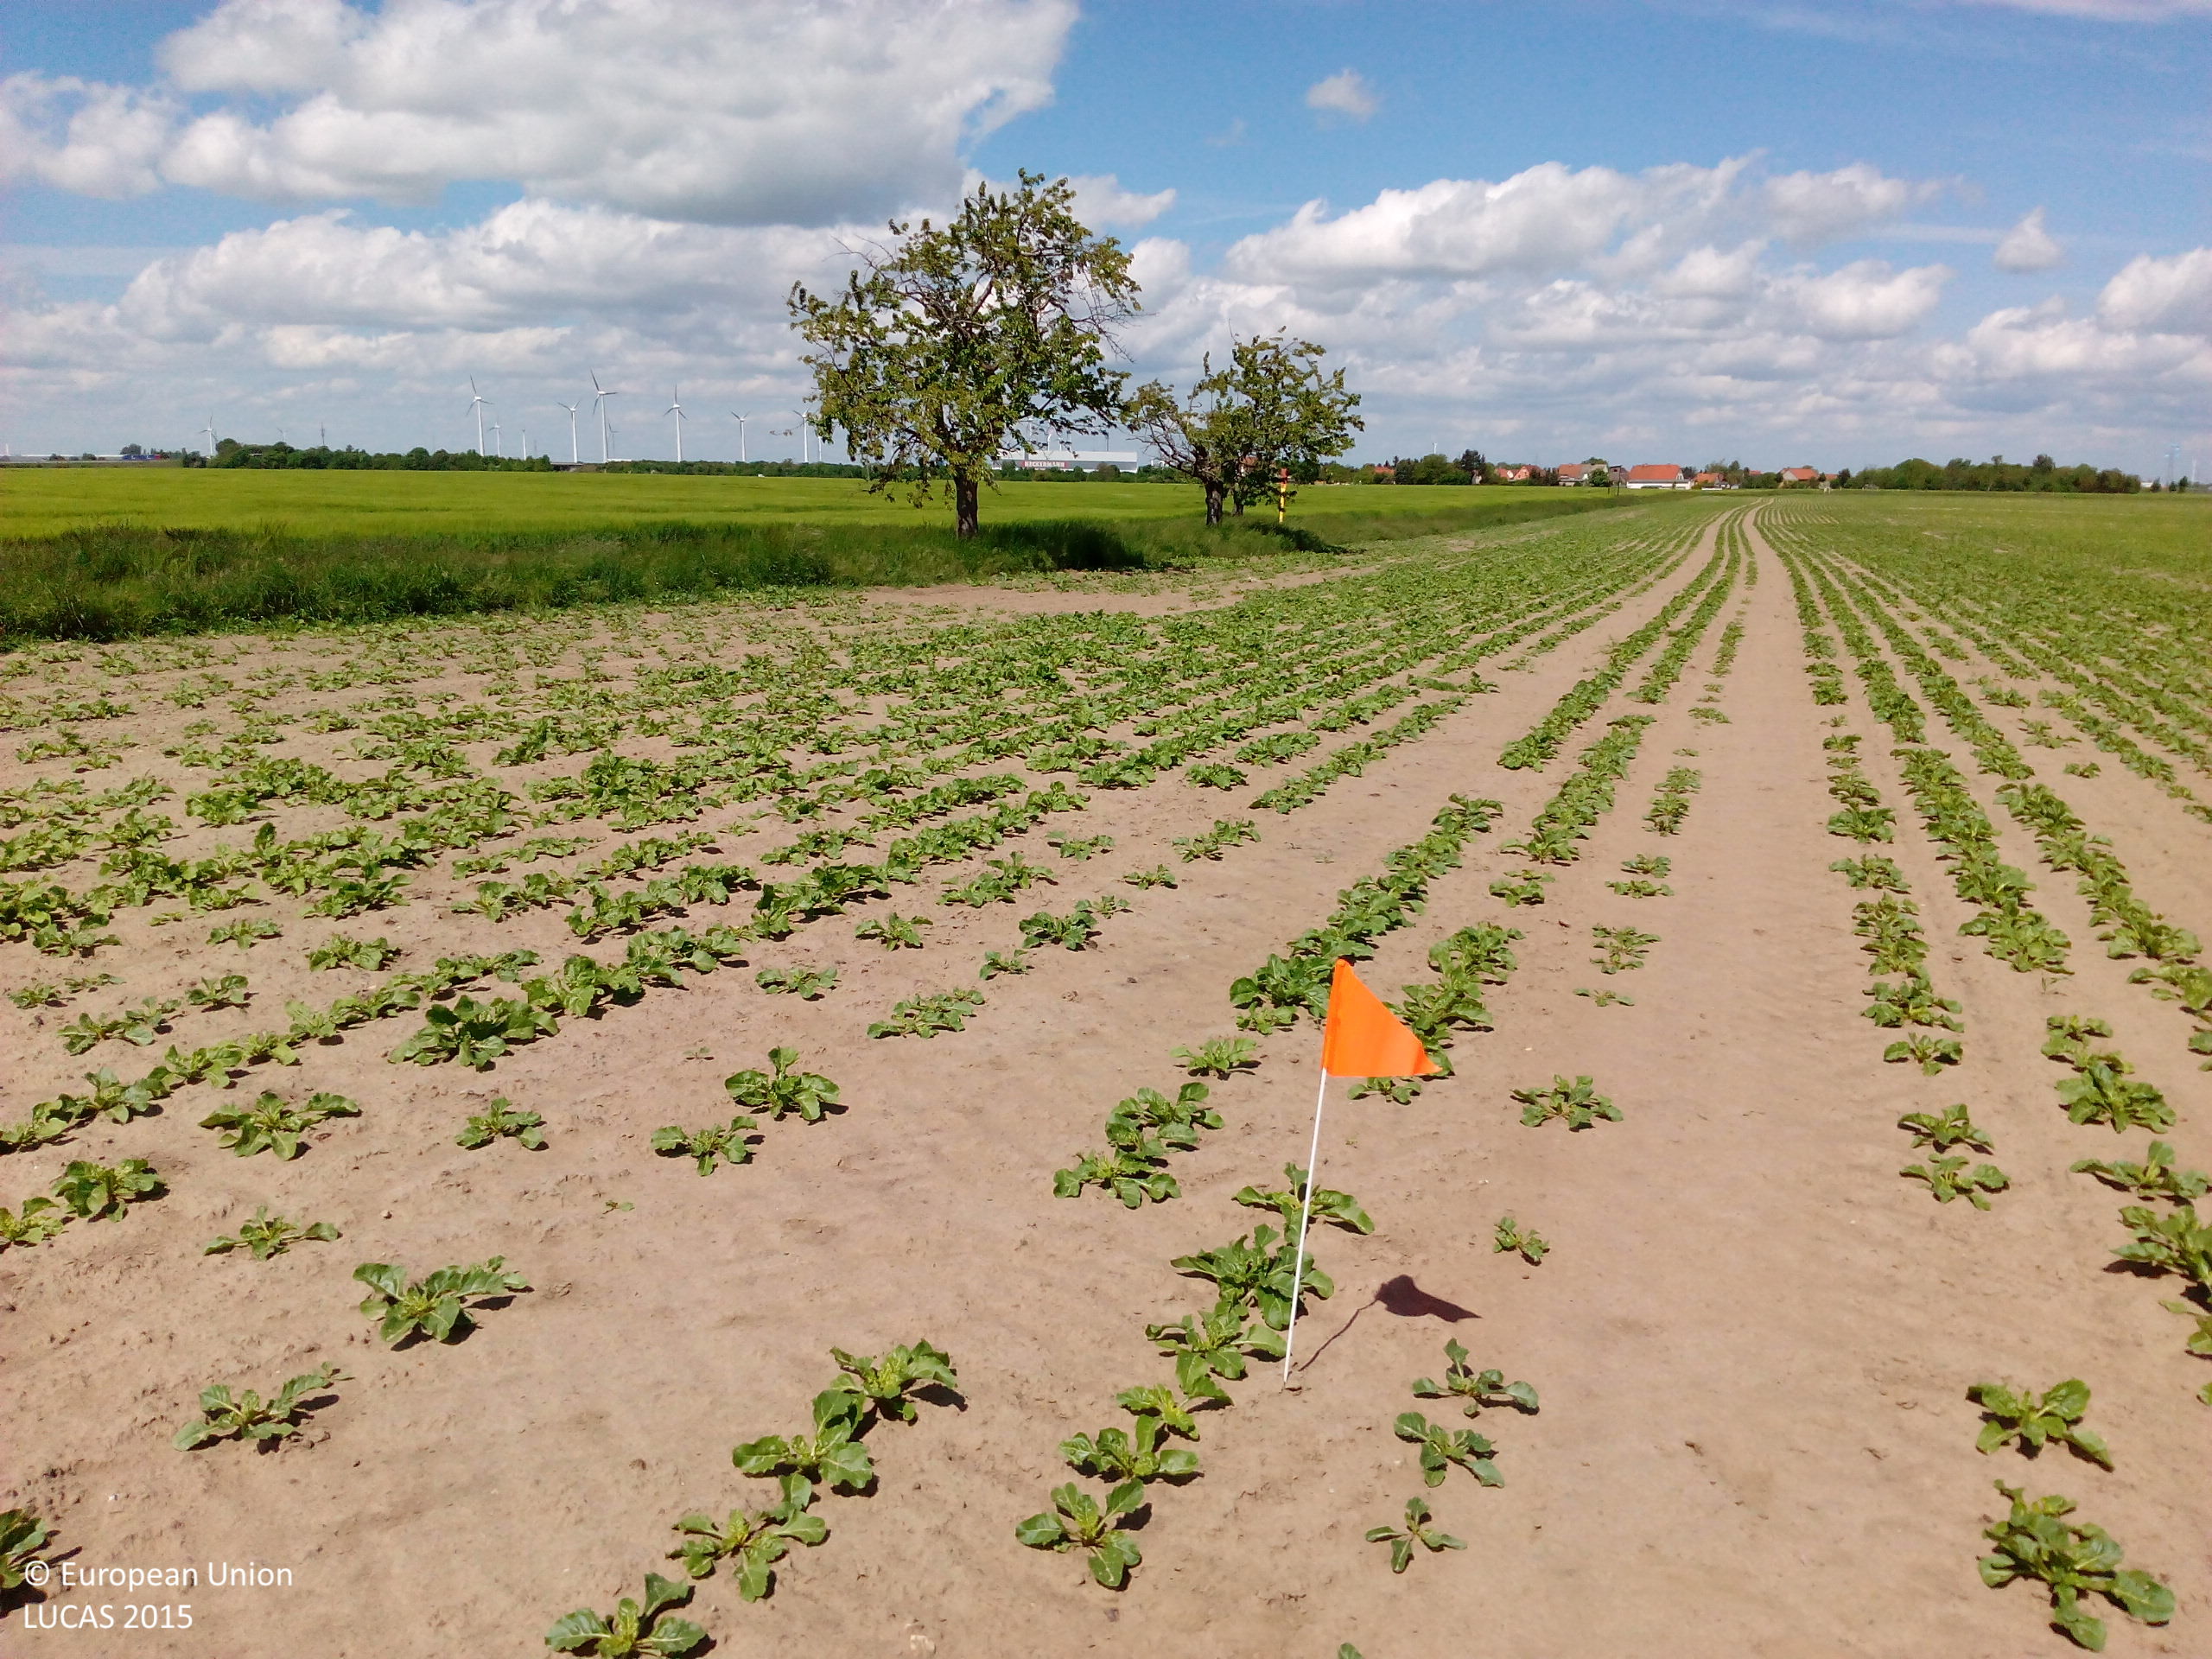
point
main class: Cropland
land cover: Sugar beet
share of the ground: 50 - 75 %
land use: Agriculture (excluding fallow land and kitchen gardens)
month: May
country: DE
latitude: 51.6197
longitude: 12.2095
